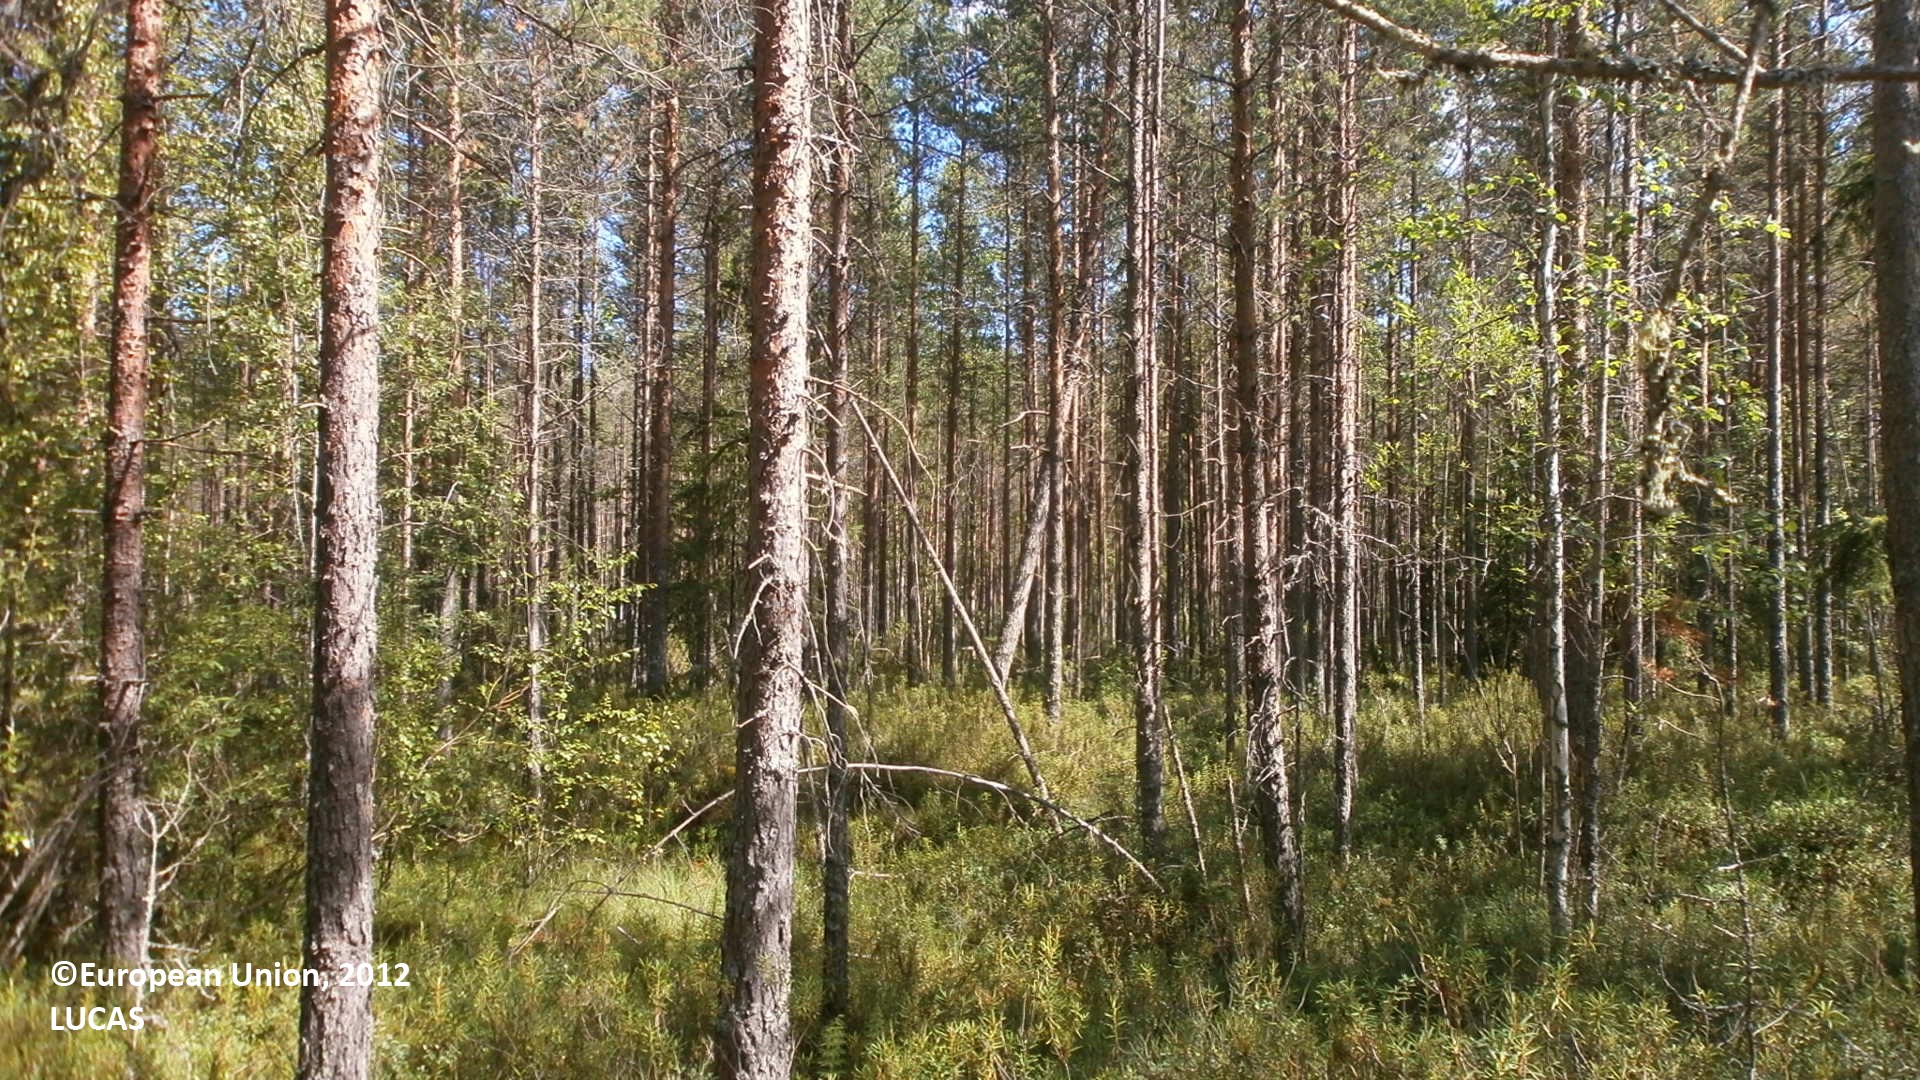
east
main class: Woodland
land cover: Pine dominated coniferous woodland
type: mire and swamp forests
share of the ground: 50 - 75 %
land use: Forestry
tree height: > 5 m
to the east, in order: Pine dominated coniferous woodland; Ditches and canals; Shruby margins; Tracks; Shruby margins; Ditches and canals; Pine dominated coniferous woodland; Ditches and canals; Pine dominated coniferous woodland
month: July
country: FI
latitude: 64.1462
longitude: 24.3548
